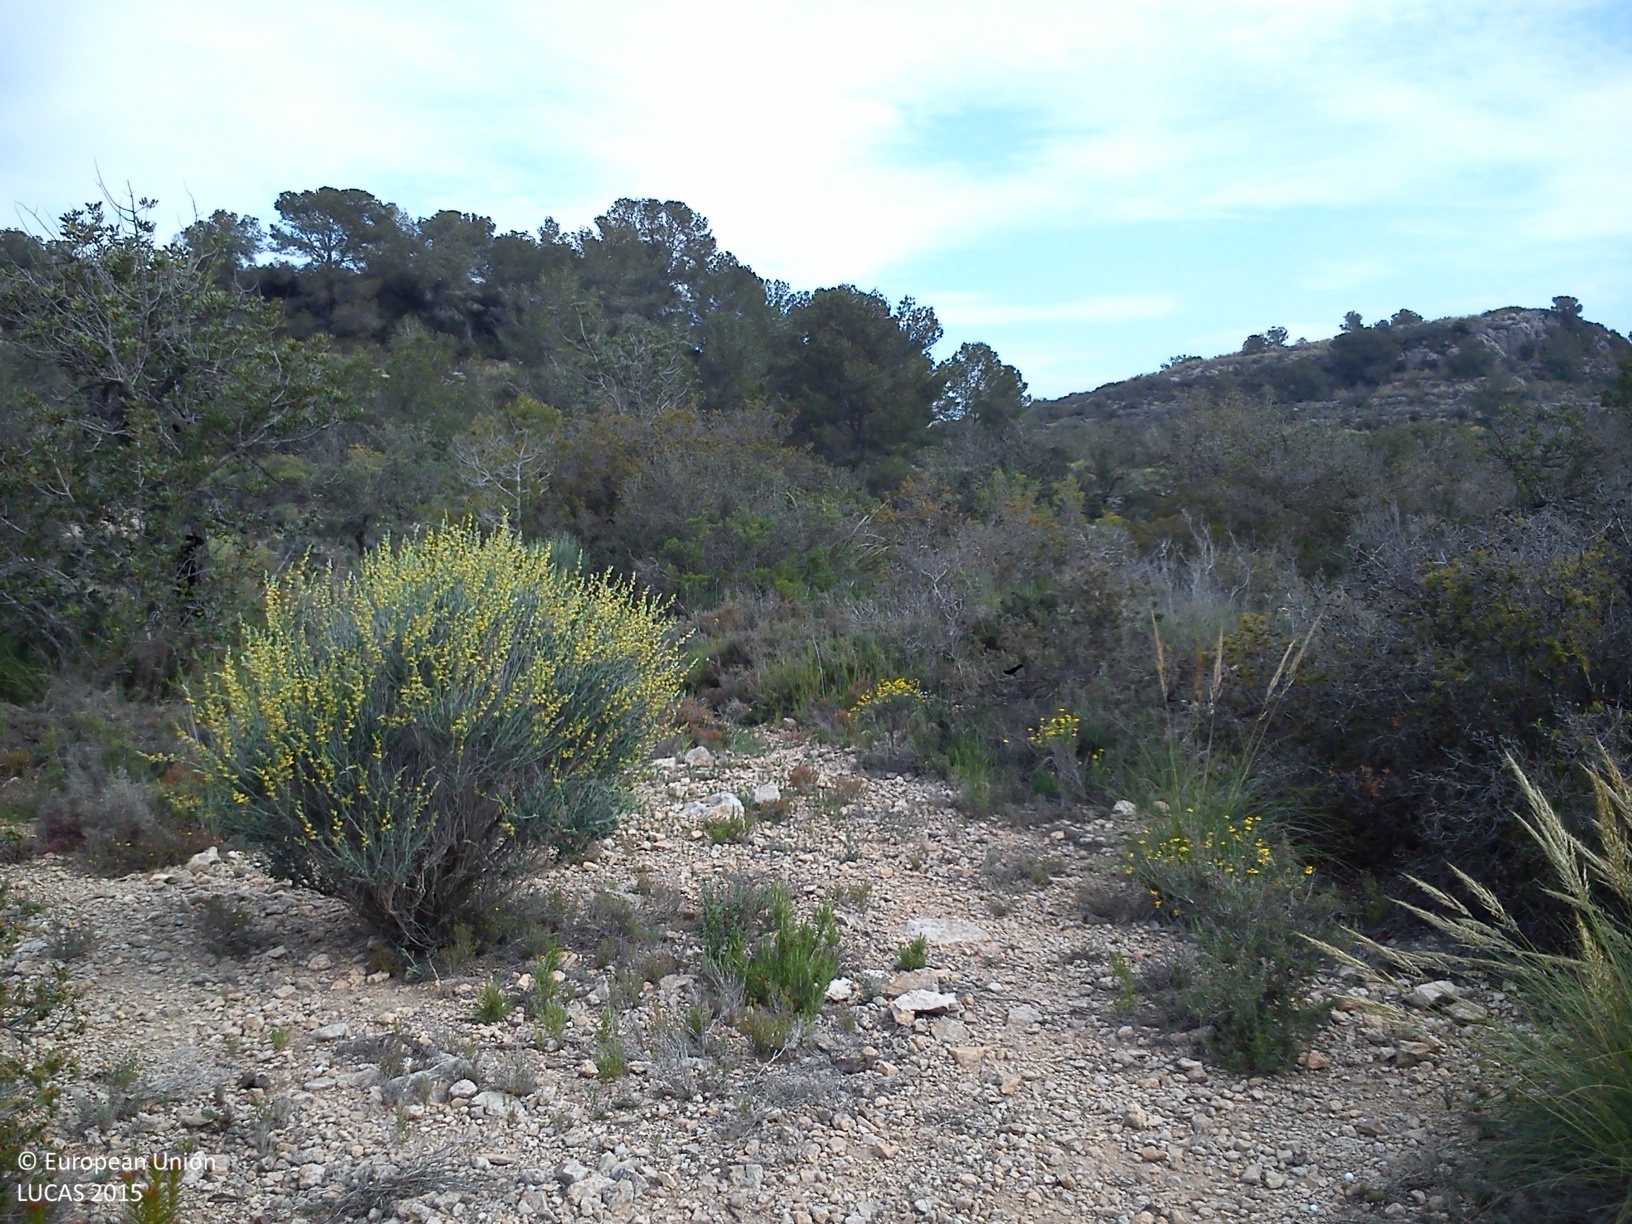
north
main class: Shrubland
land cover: Shrubland with sparse tree cover
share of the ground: > 75 %
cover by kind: shrubs 65 %, consolidated bare surface 20 %, herbaceous plants 10 %, coniferous forest trees 5 %
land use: Semi-natural and natural areas not in use
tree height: > 5 m
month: April
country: ES
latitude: 39.5097
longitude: -0.5942
